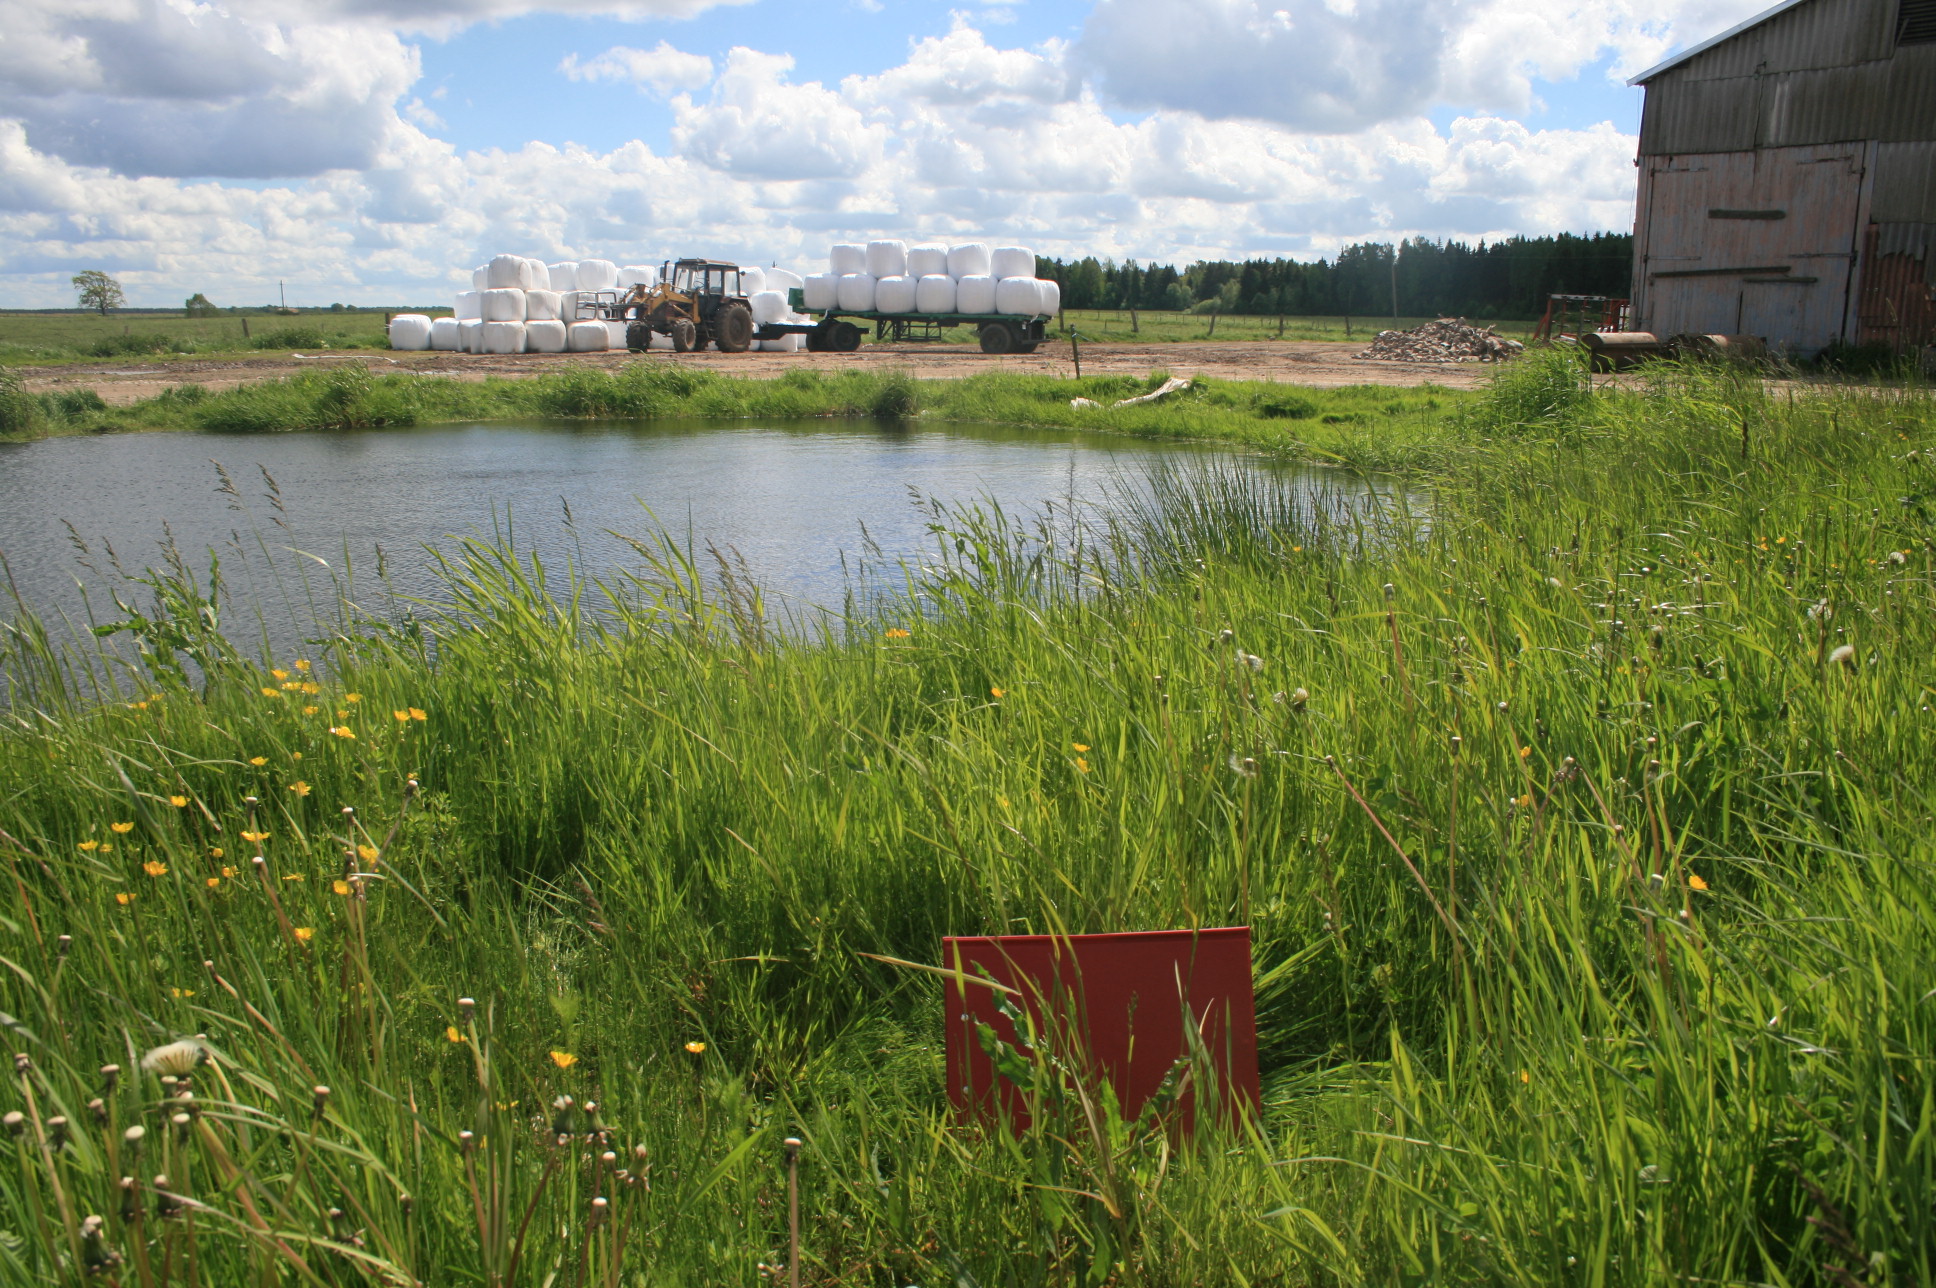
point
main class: Grassland
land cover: Grassland without tree/shrub cover
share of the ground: > 75 %
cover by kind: herbaceous plants 100 %
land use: Agriculture (excluding fallow land and kitchen gardens)
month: May
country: LT
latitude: 55.9919
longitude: 22.3204
